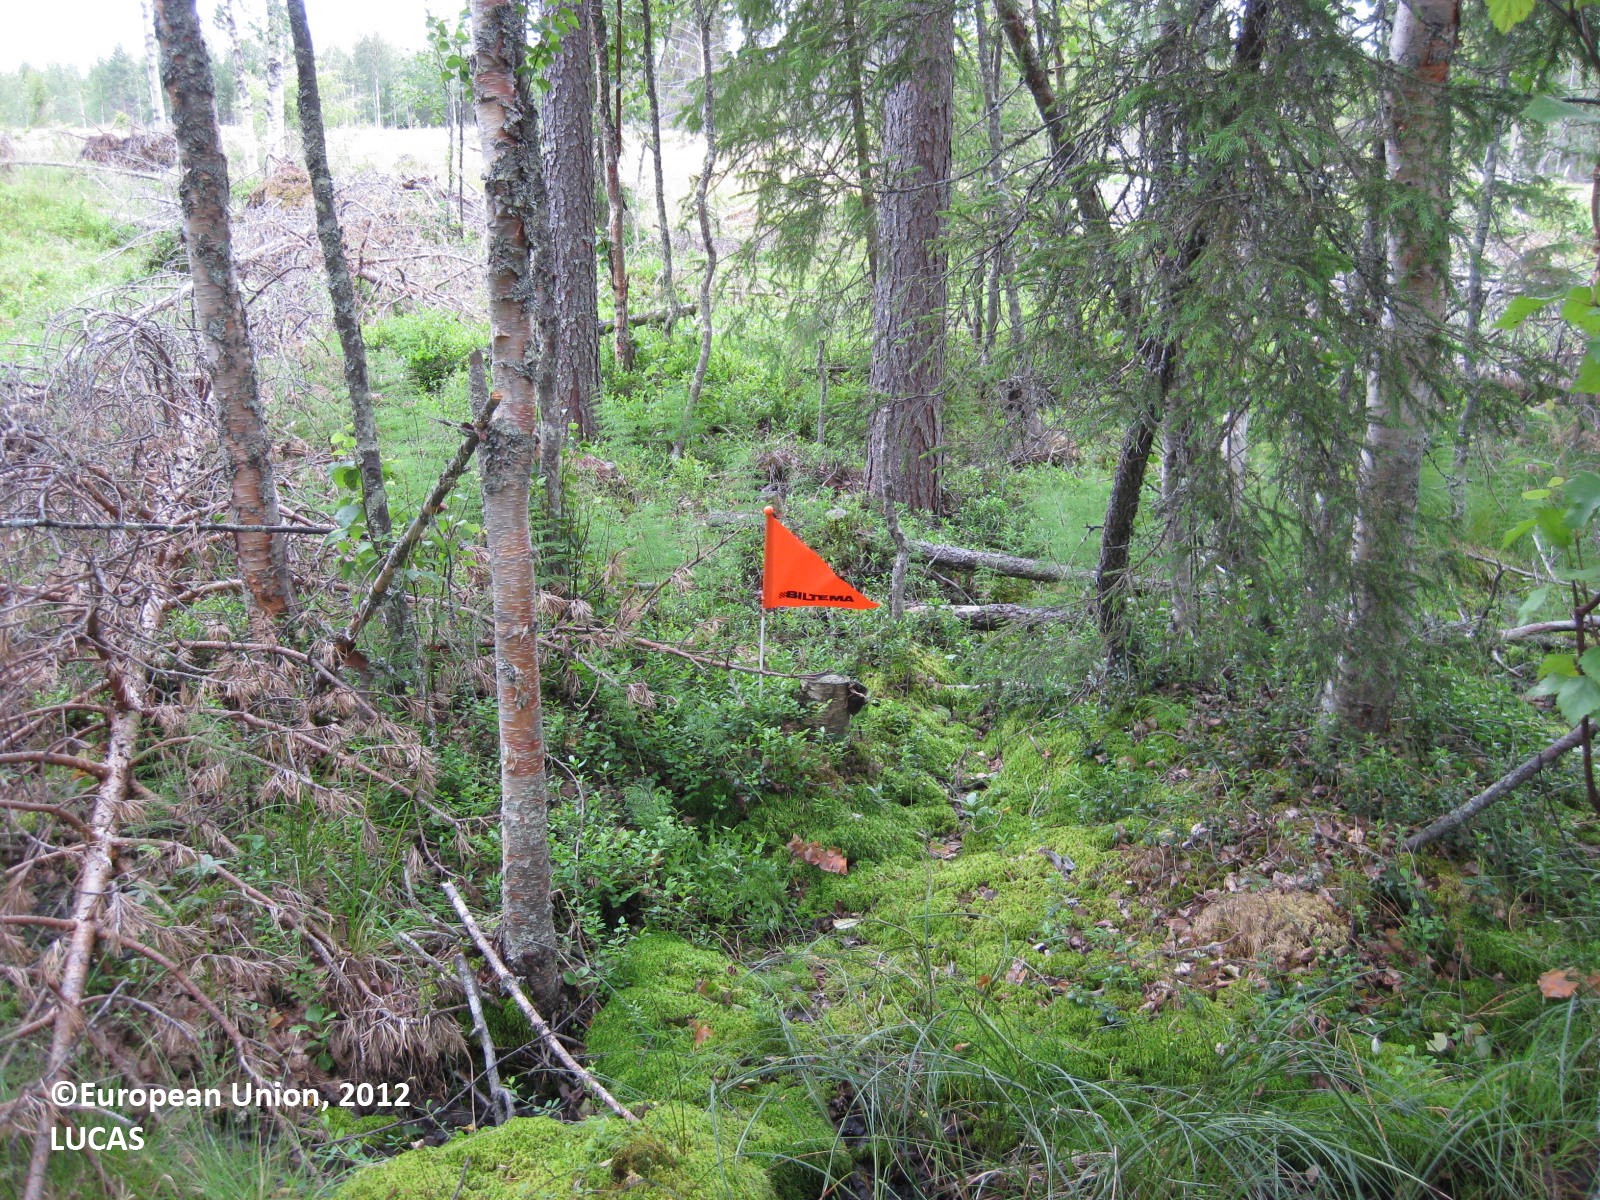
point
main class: Woodland
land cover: Pine dominated mixed woodland
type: boreal forest
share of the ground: > 75 %
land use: Forestry
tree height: > 5 m
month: July
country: FI
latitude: 65.9063
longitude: 29.6707
